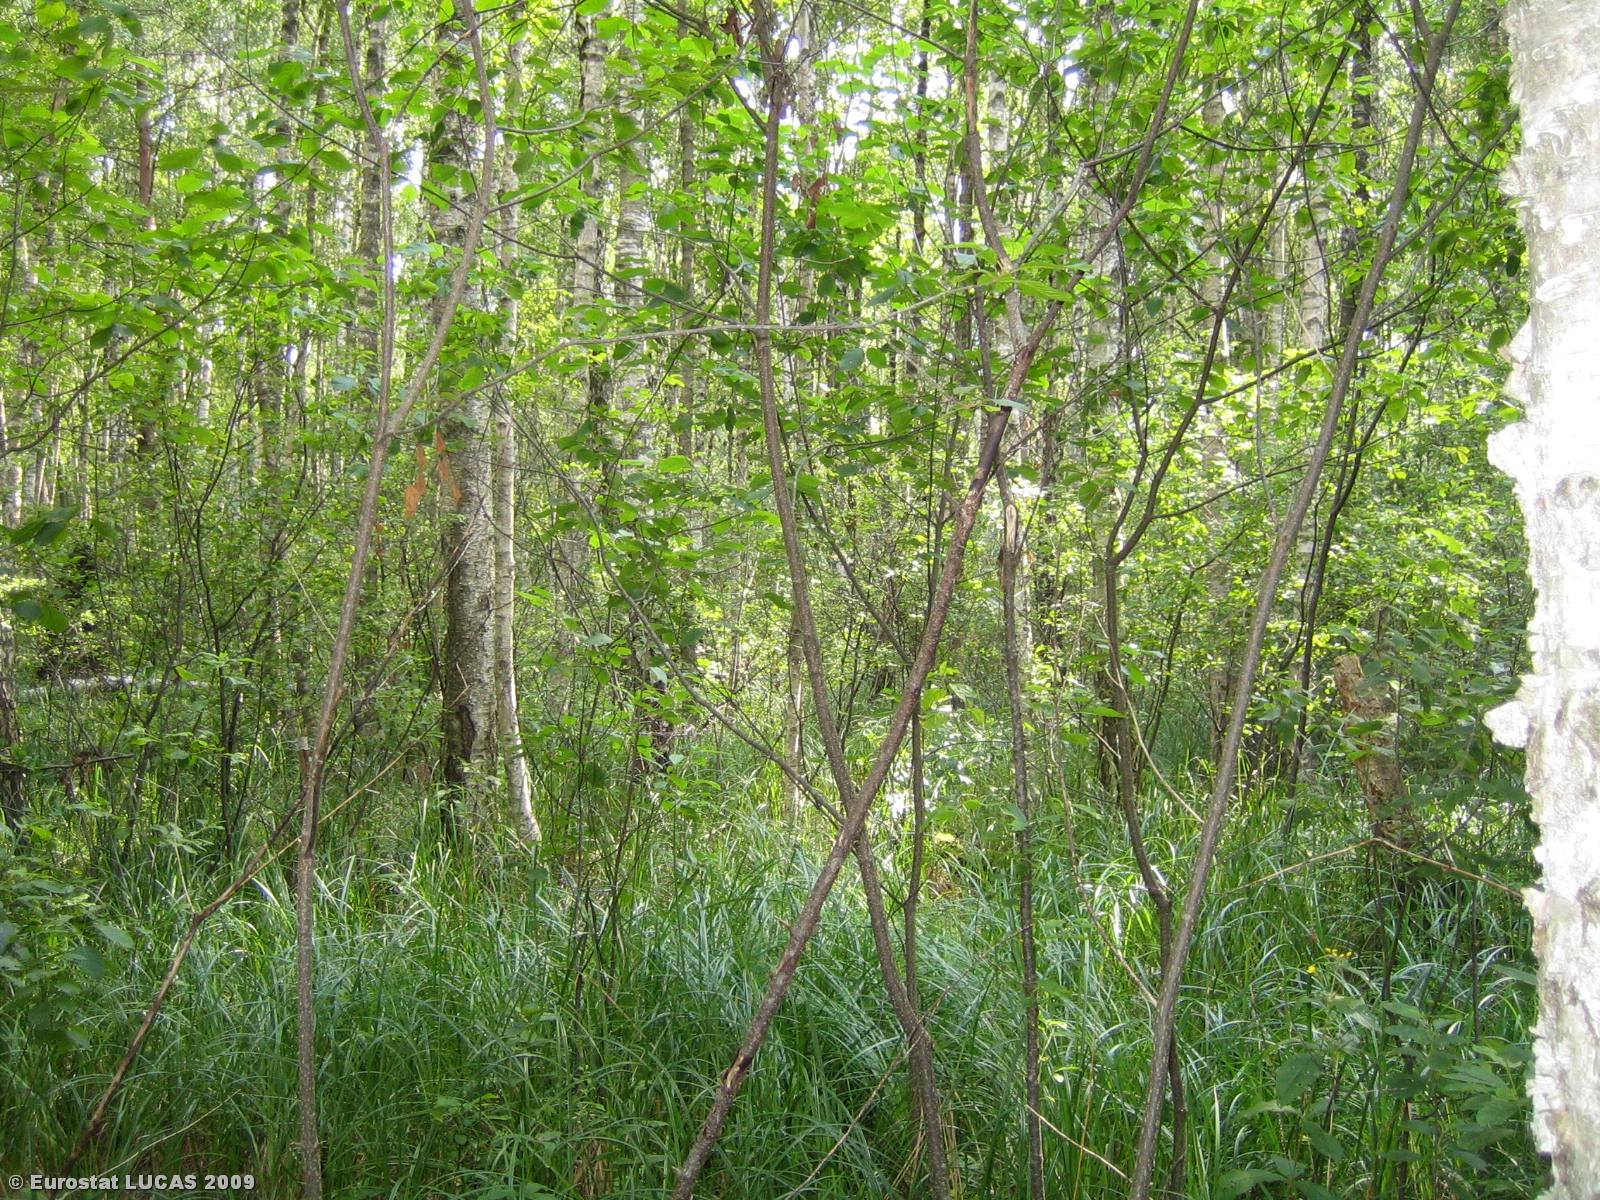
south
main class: Woodland
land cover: Broadleaved woodland
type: hemiboreal forest and nemoral coniferous forest and mixed broadleaved-coniferous forest
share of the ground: > 75 %
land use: Forestry
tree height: > 5 m
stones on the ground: < 10 %
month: July
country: LT
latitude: 55.5670
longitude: 25.6528
